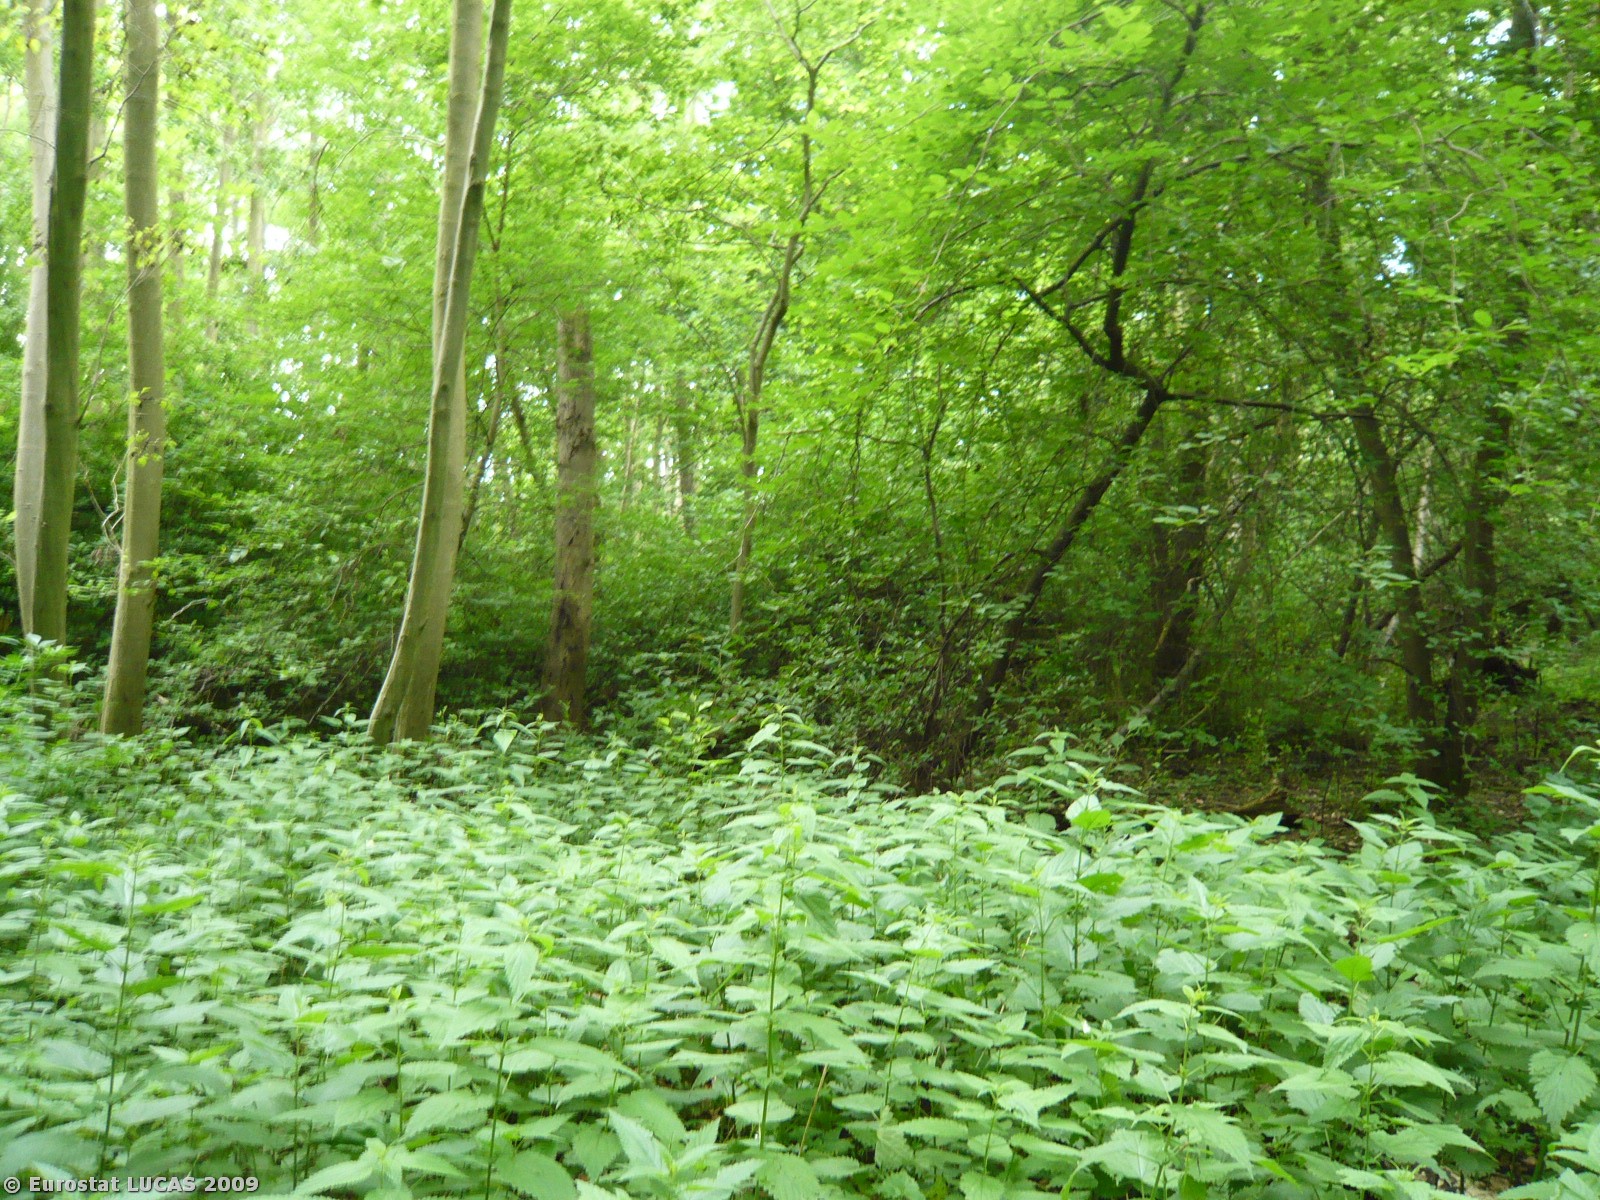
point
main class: Woodland
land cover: Broadleaved woodland
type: mesophytic deciduous forest
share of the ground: > 75 %
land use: Forestry
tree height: > 5 m
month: June
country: DK
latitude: 54.7747
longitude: 11.6623
